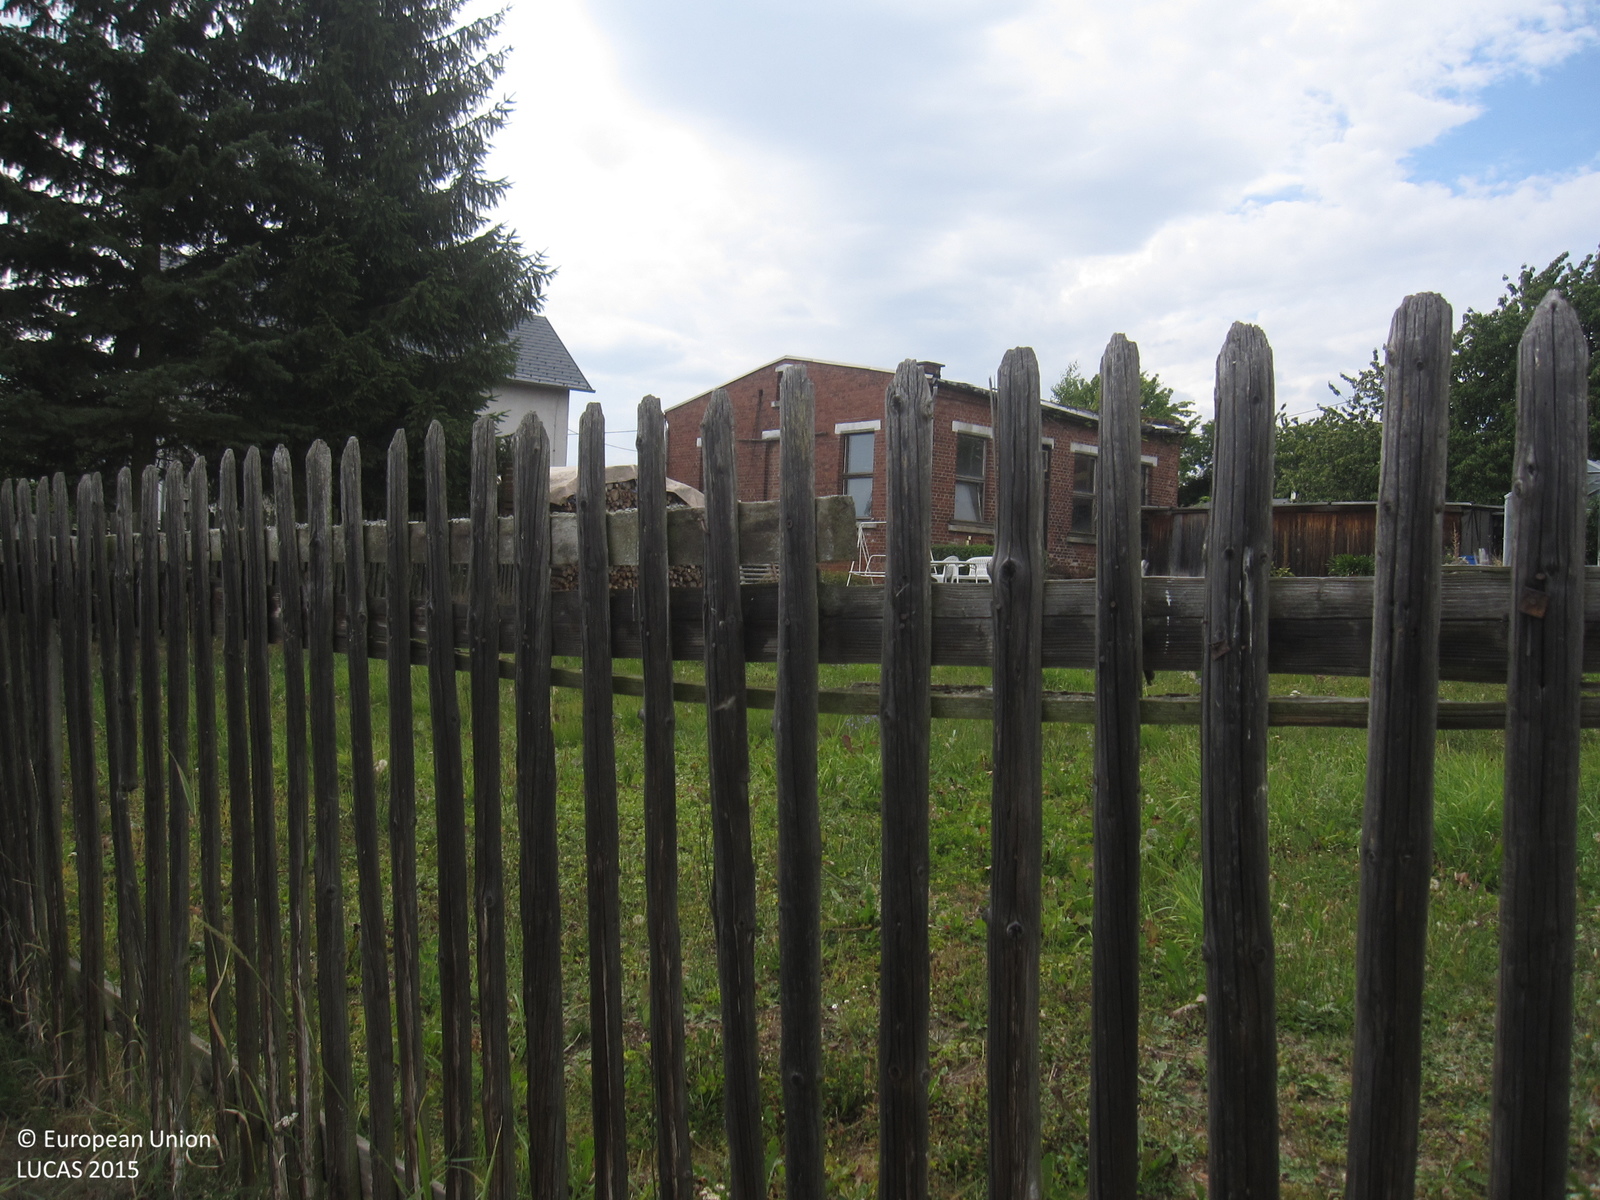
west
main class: Woodland
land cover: Broadleaved woodland
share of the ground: 25 - 50 %
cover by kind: herbaceous plants 65 %, broadleaved forest trees 35 %
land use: Residential
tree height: > 5 m
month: August
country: DE
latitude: 50.5601
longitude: 12.1312
